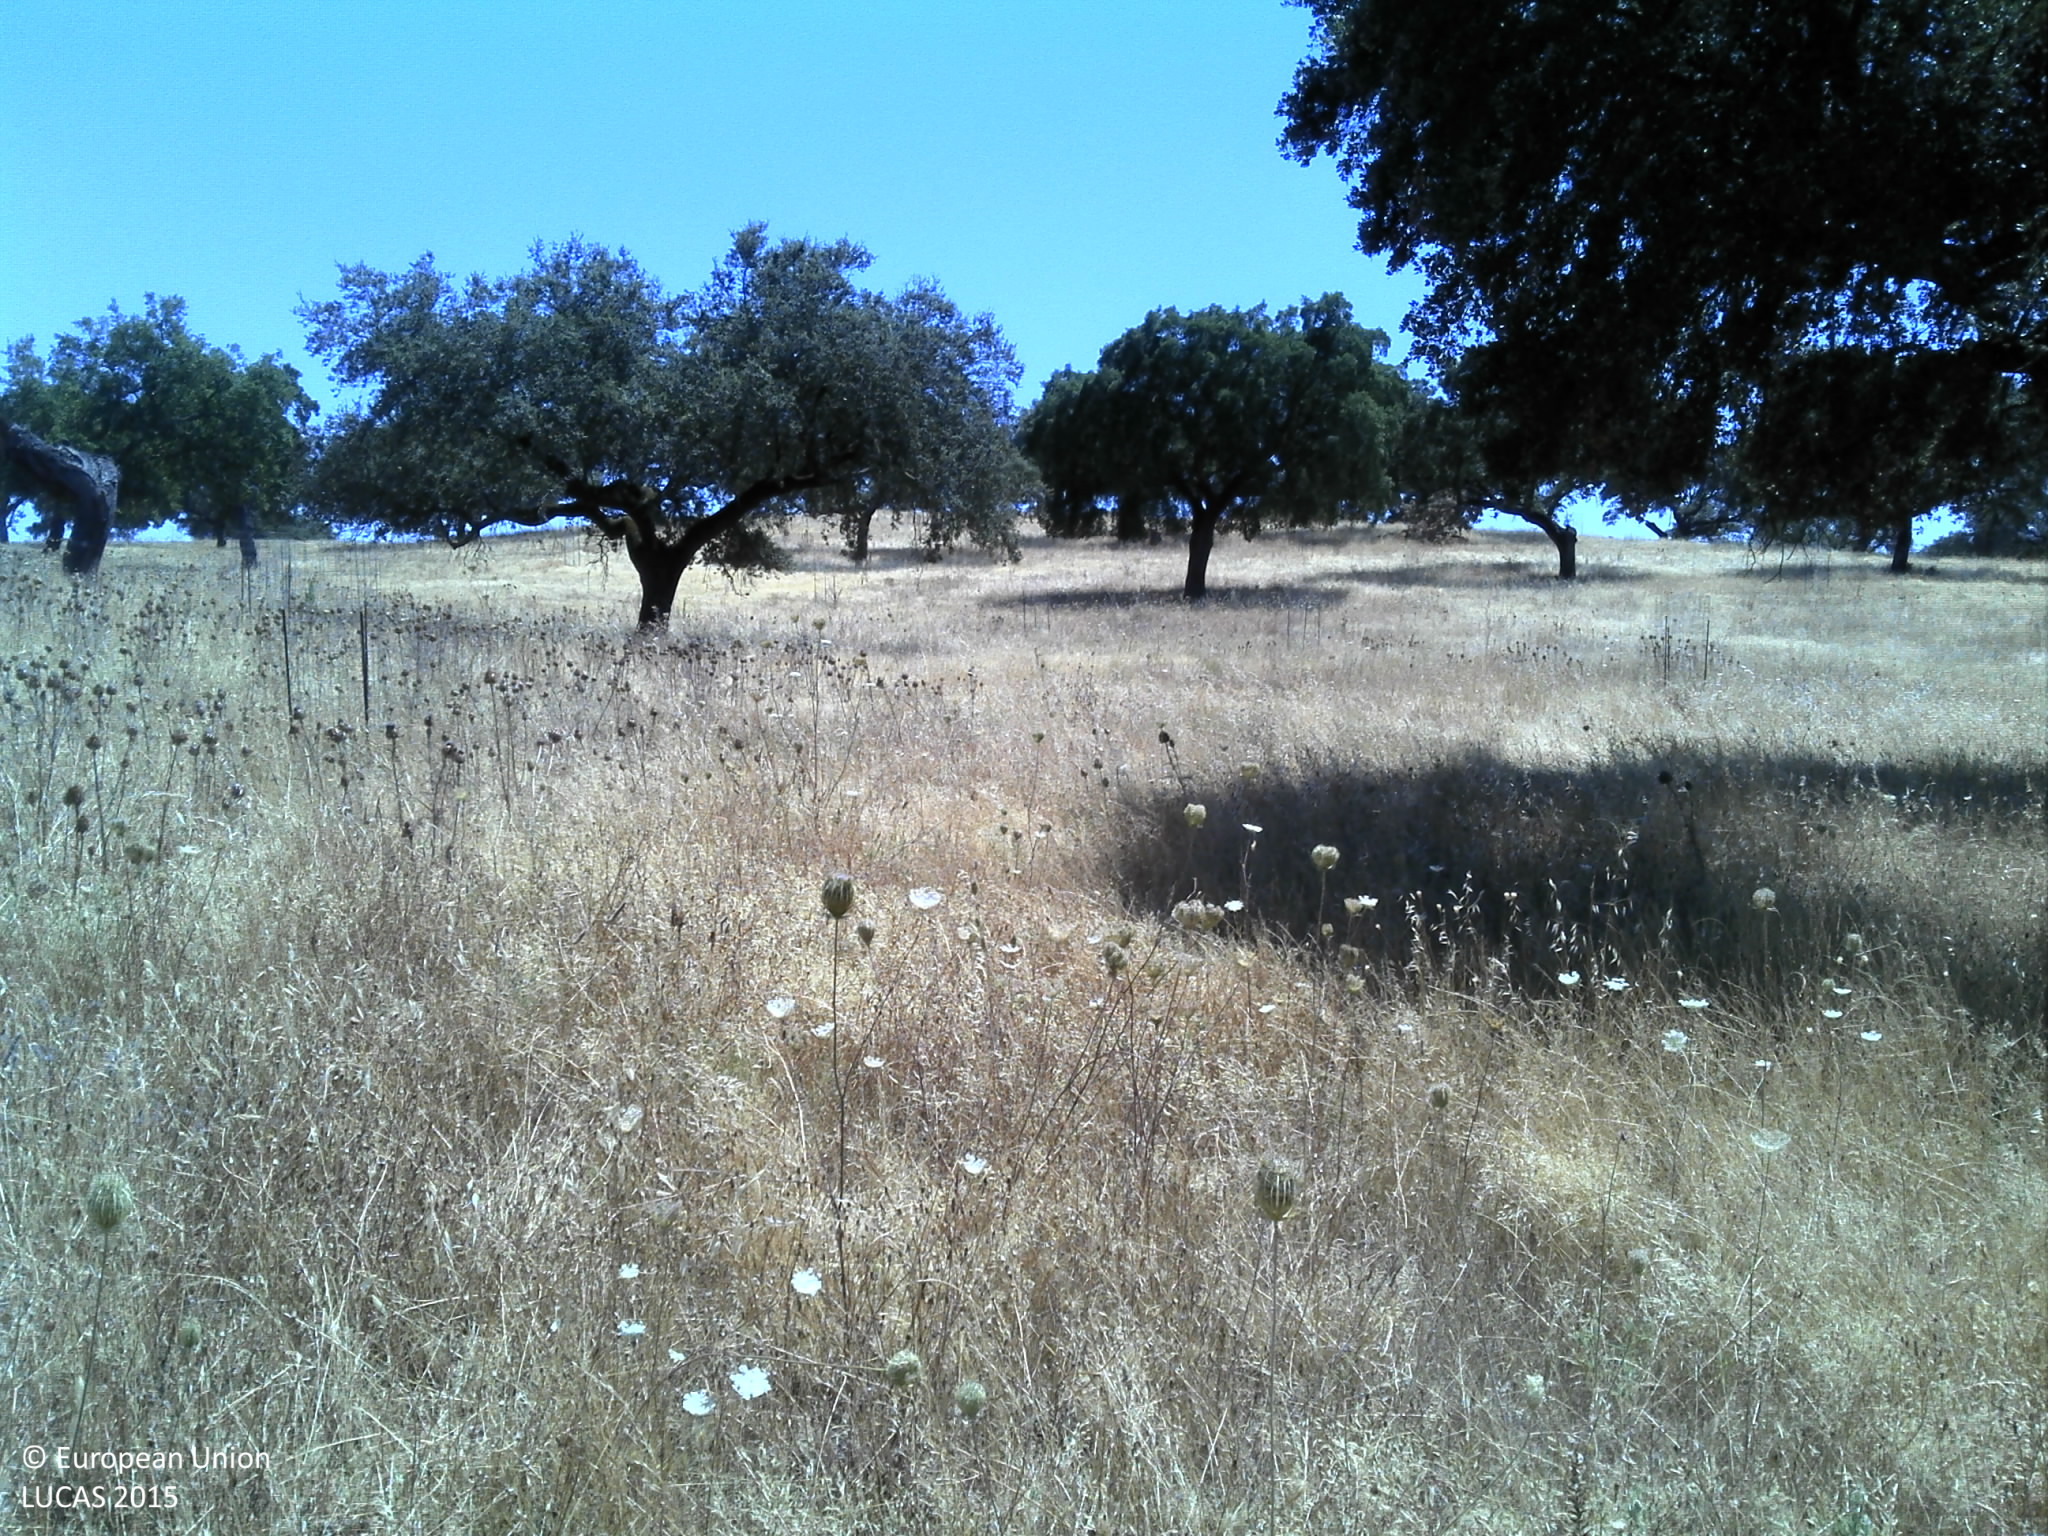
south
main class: Woodland
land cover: Broadleaved woodland
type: broadleaved evergreen forest
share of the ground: 25 - 50 %
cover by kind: herbaceous plants 70 %, broadleaved forest trees 30 %
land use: Forestry
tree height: > 5 m
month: June
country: PT
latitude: 37.9990
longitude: -7.2898
